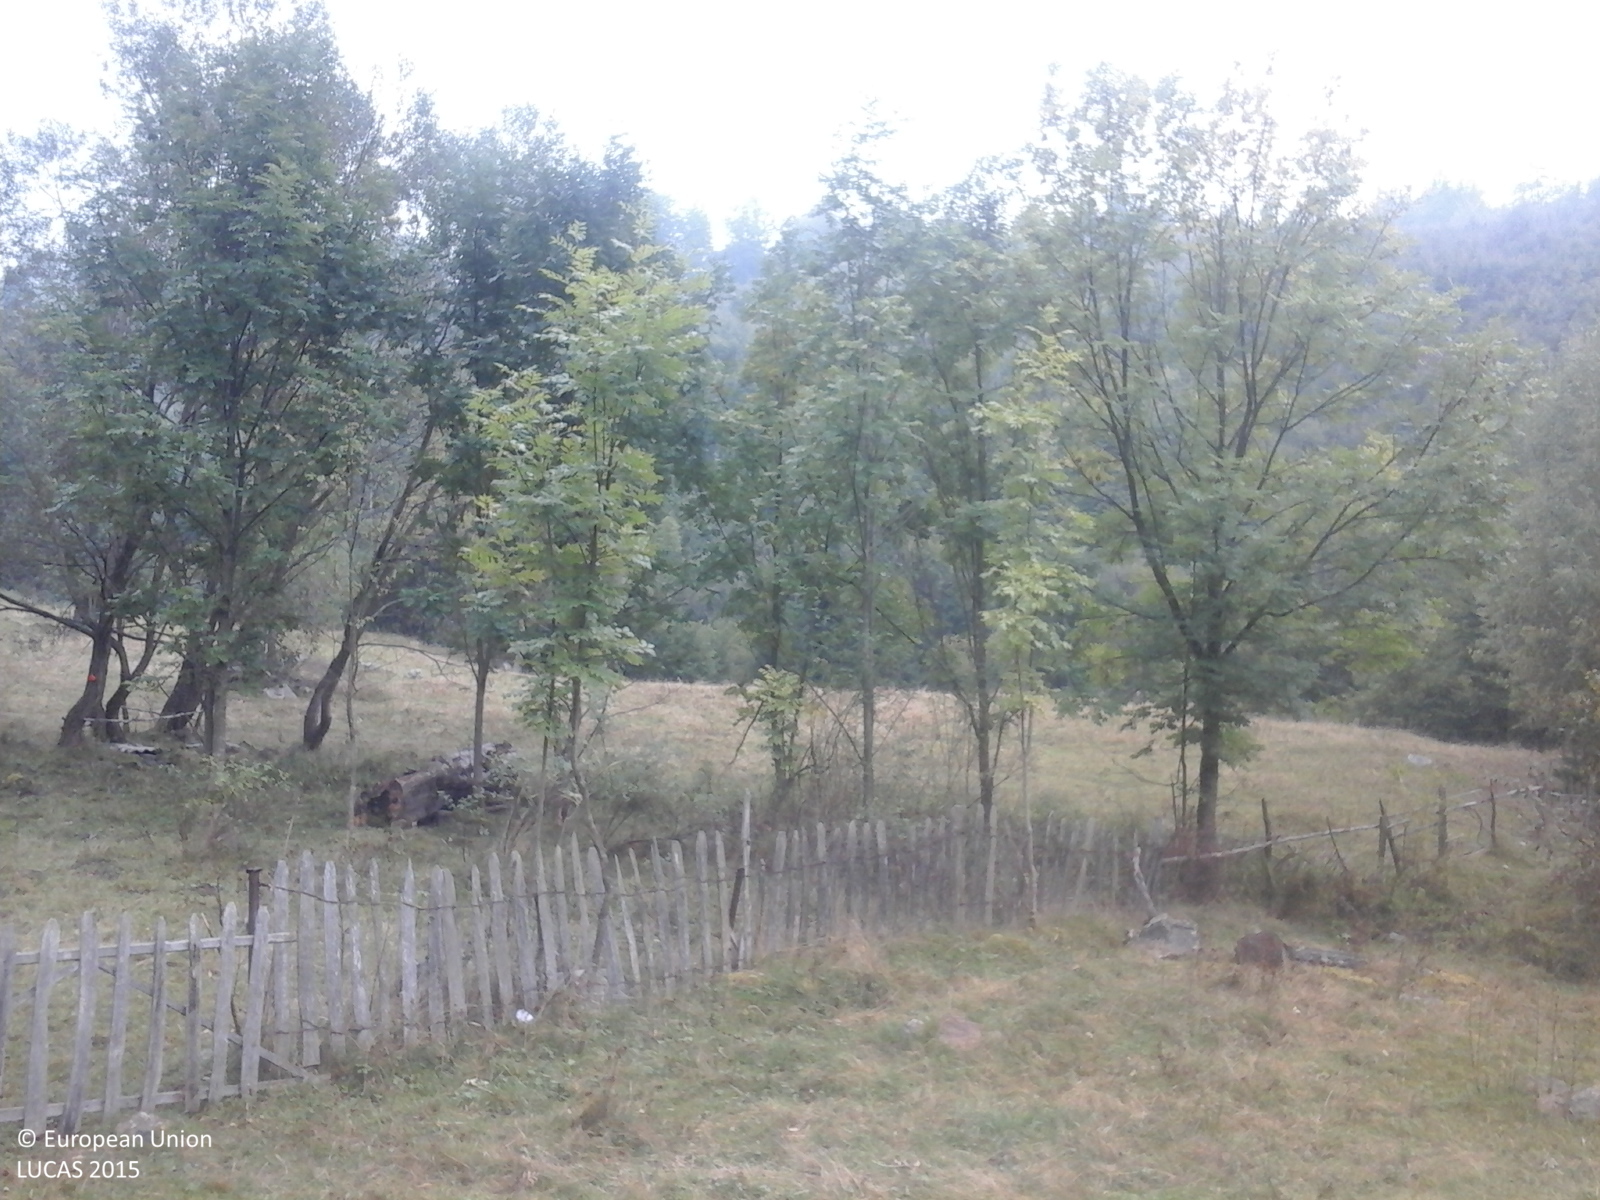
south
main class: Grassland
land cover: Grassland without tree/shrub cover
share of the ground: > 75 %
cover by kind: herbaceous plants 100 %
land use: Agriculture (excluding fallow land and kitchen gardens)
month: September
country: RO
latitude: 45.3690
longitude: 23.4530
